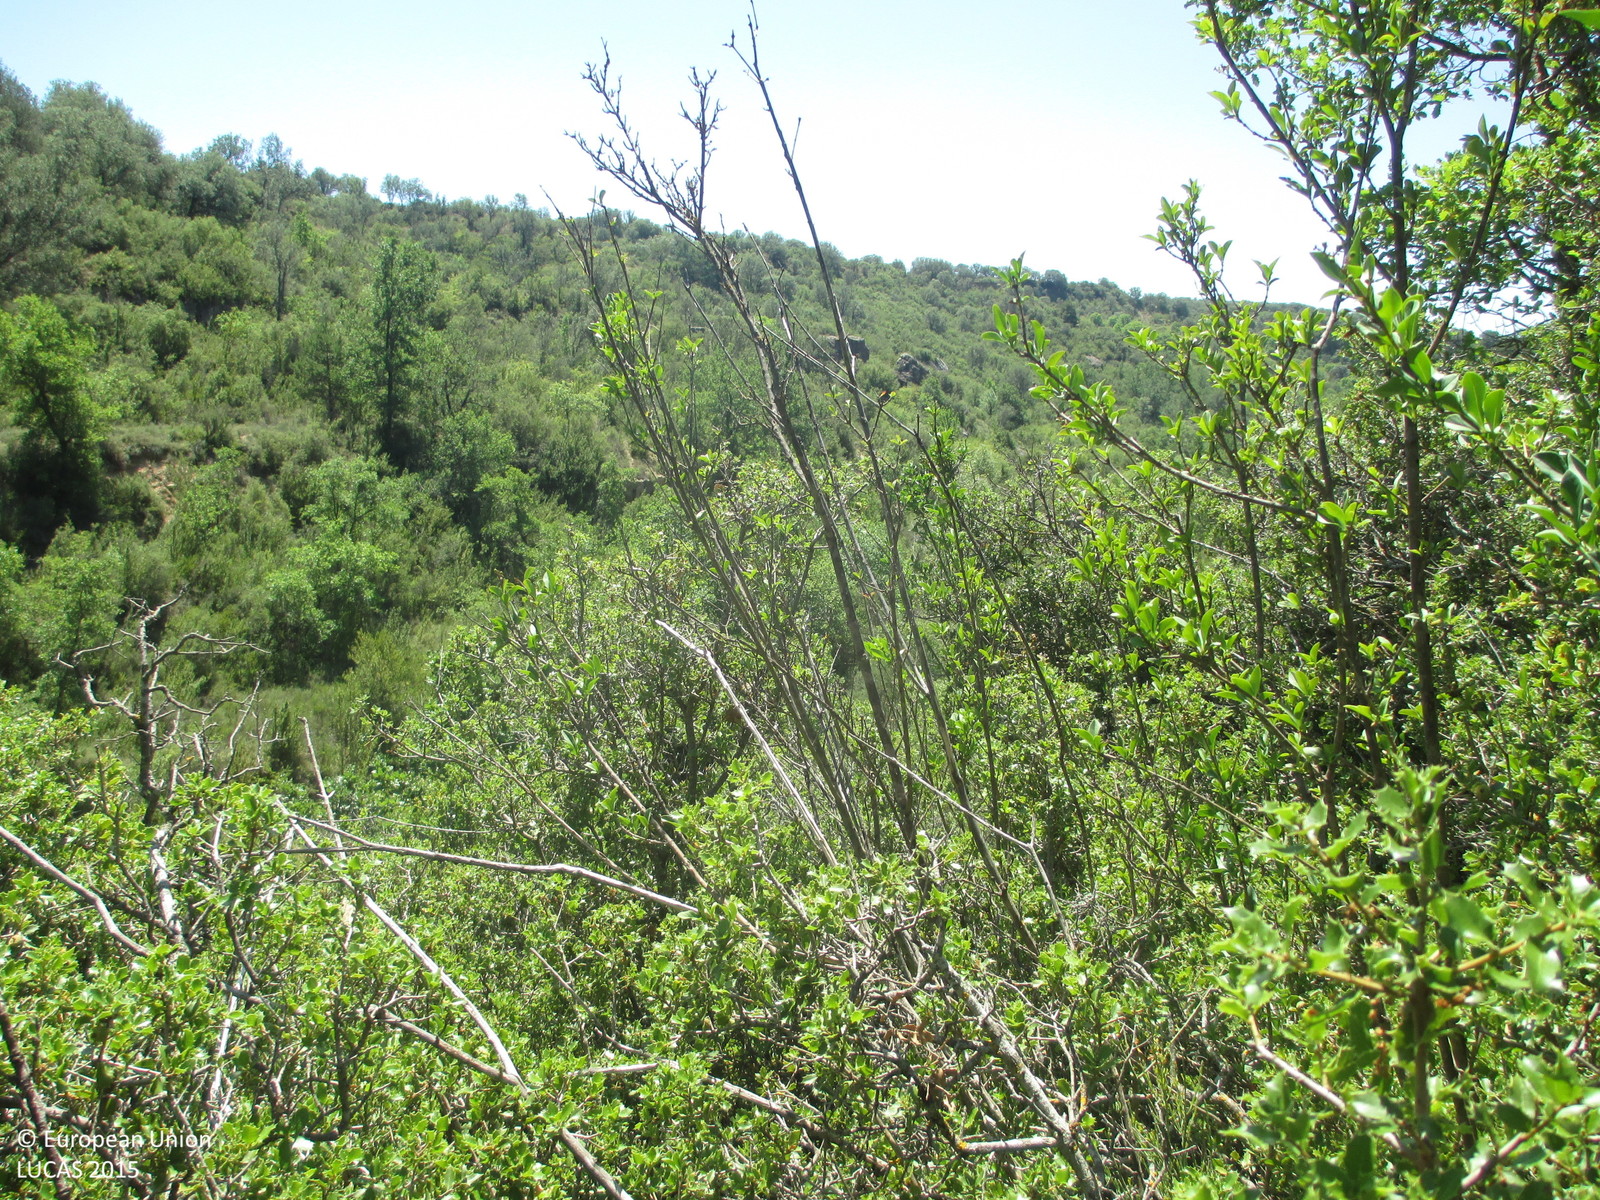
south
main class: Woodland
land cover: Broadleaved woodland
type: broadleaved evergreen forest
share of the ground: > 75 %
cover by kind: broadleaved forest trees 90 %, coniferous forest trees 5 %, shrubs 5 %
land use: Semi-natural and natural areas not in use
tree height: > 5 m
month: June
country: ES
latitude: 42.1527
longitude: -0.0527
